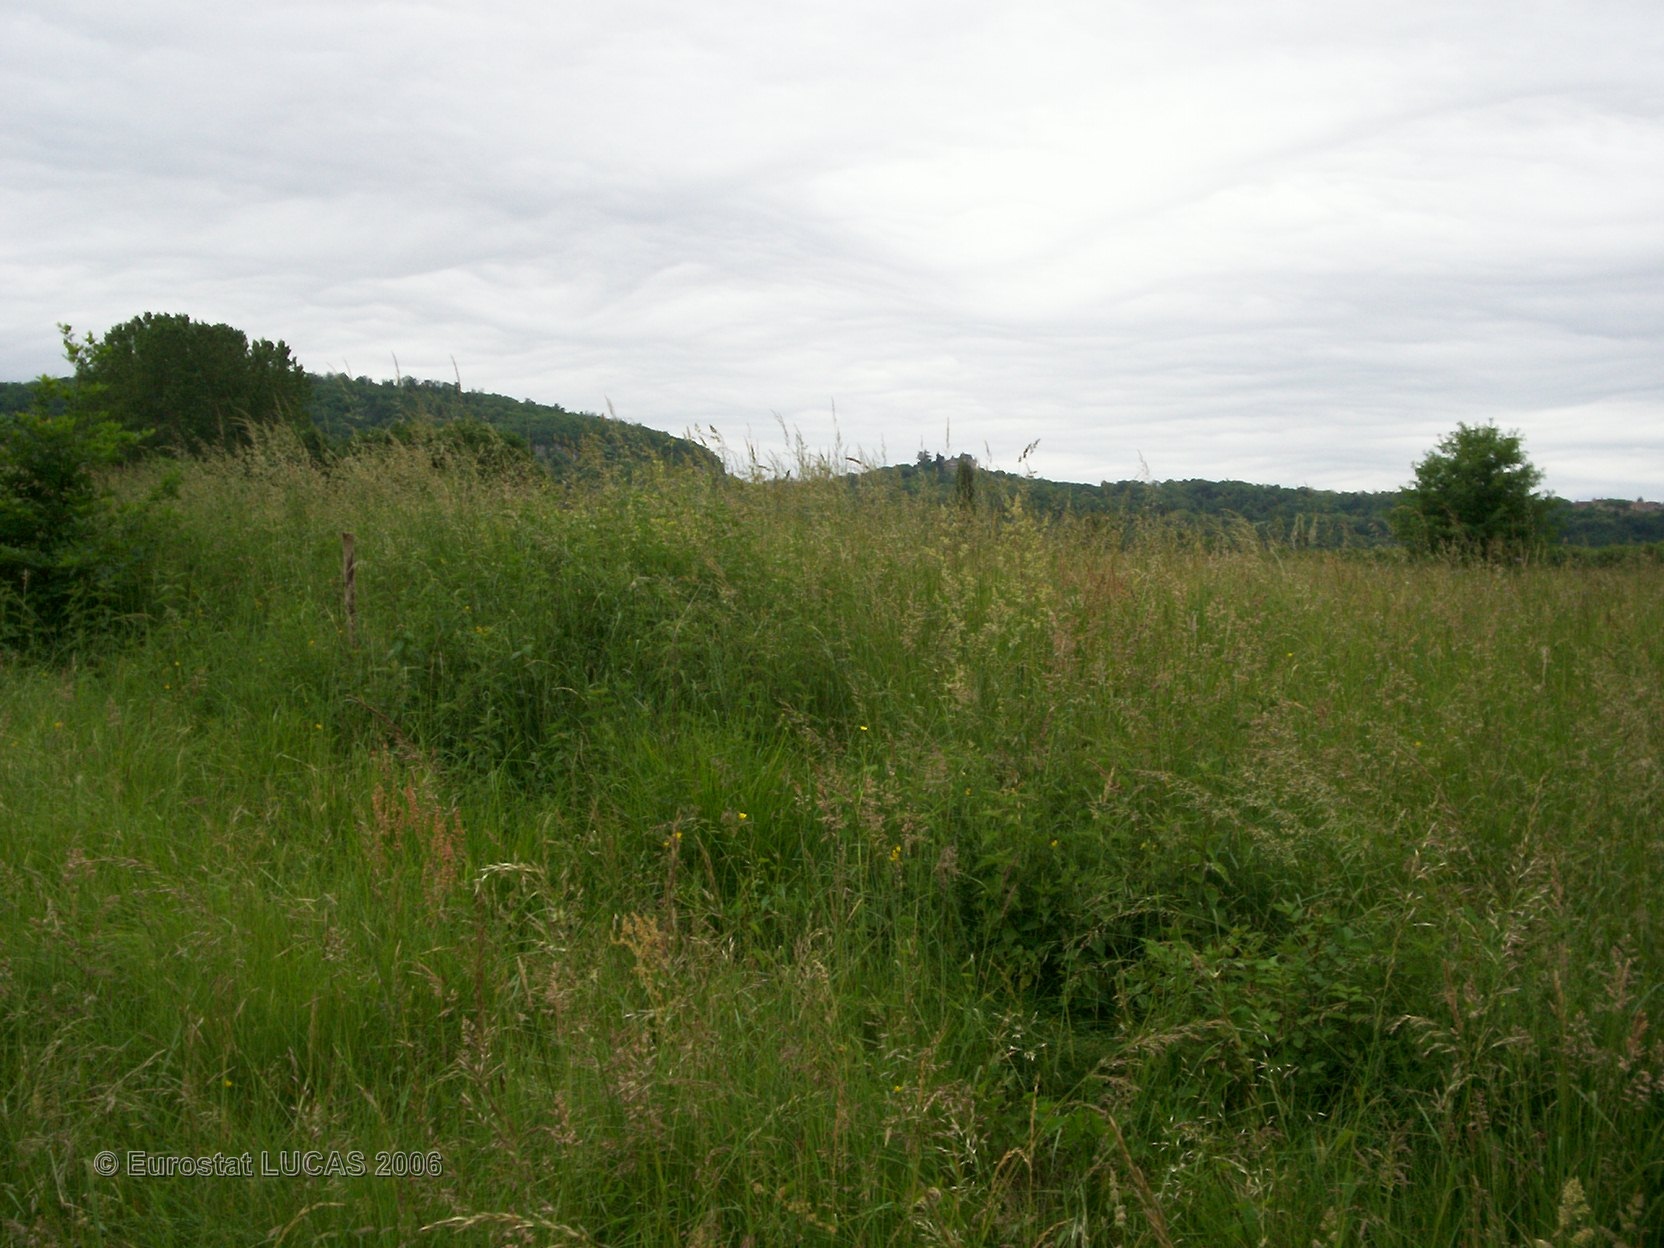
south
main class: Grassland
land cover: Grassland without tree/shrub cover
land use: Agriculture (excluding fallow land and kitchen gardens)
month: May
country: FR
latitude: 44.8591
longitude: 1.3524
